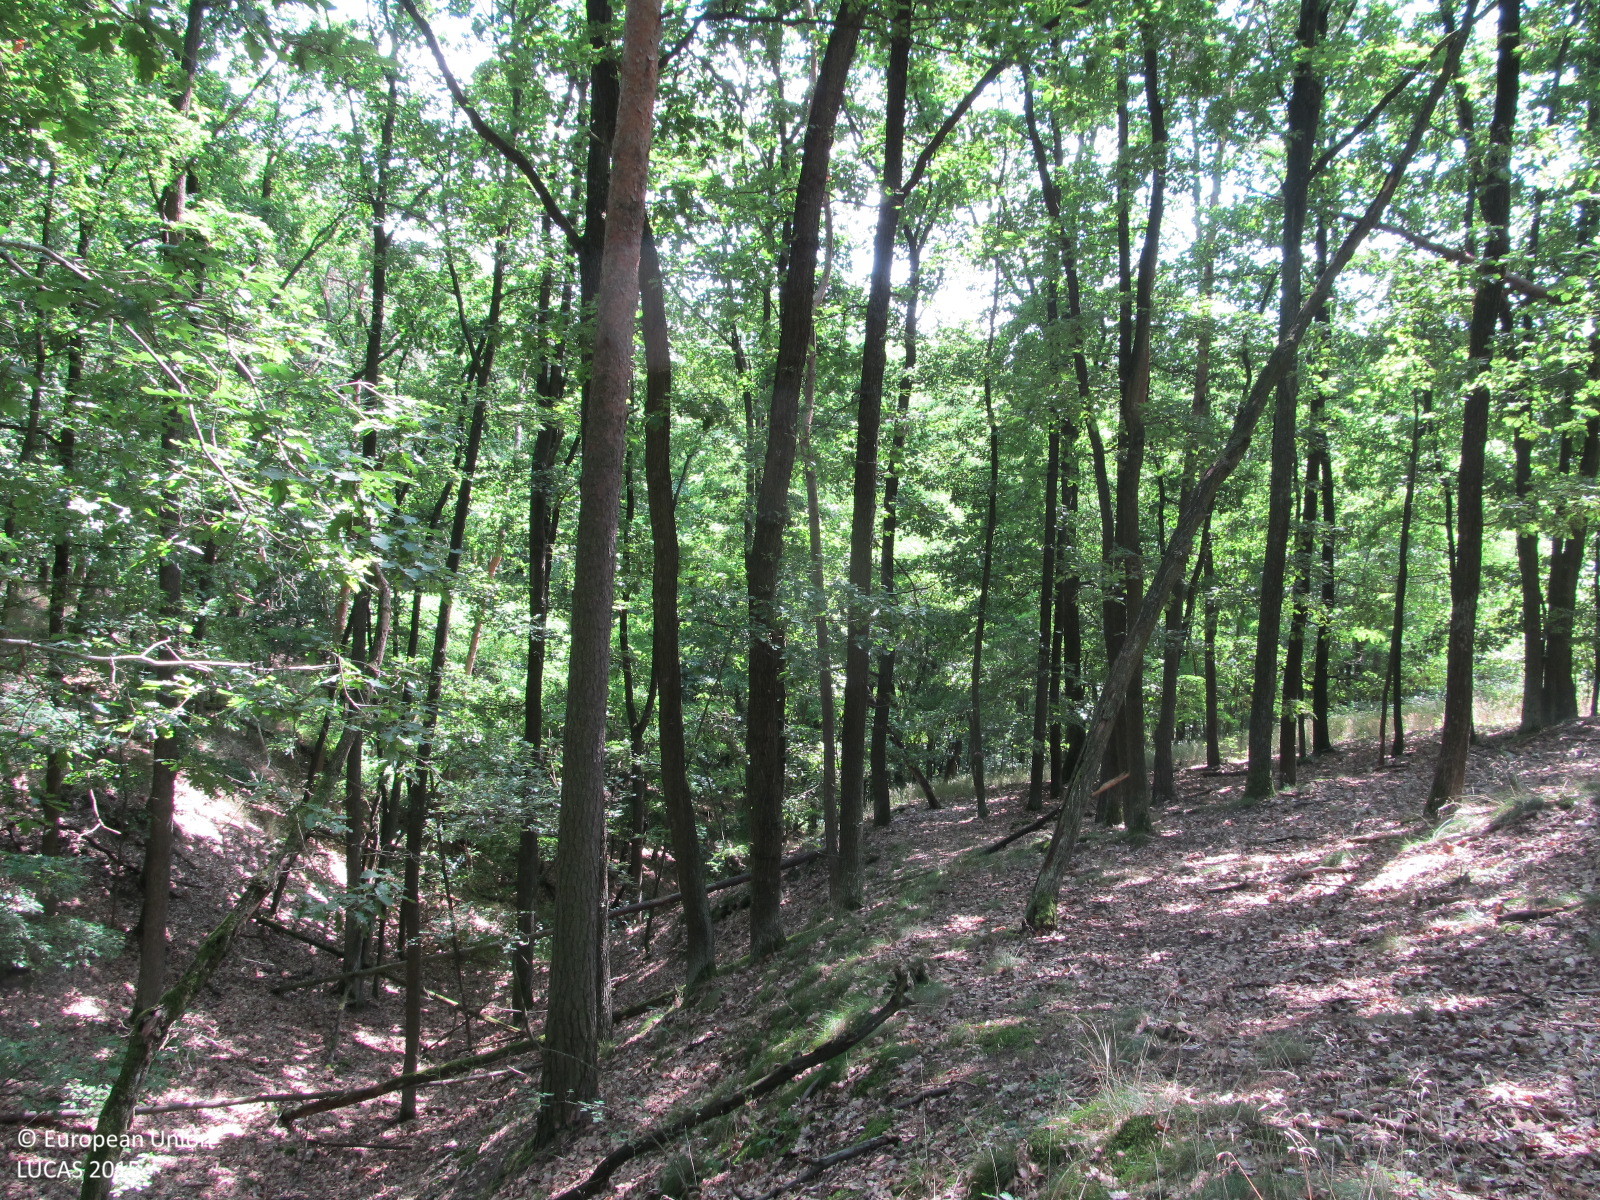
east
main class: Woodland
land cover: Other mixed woodland
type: mountainous beech forest
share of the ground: > 75 %
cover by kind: broadleaved forest trees 50 %, coniferous forest trees 25 %, shrubs 10 %, unconsolidated bare surface 10 %, herbaceous plants 5 %
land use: Forestry
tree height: > 5 m
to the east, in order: Other mixed woodland; Broadleaved woodland; Tracks; Broadleaved woodland; Fences; Tracks; Pine dominated mixed woodland; Fences; Pine dominated mixed woodland
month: July
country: AT
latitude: 48.7844
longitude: 15.9521
